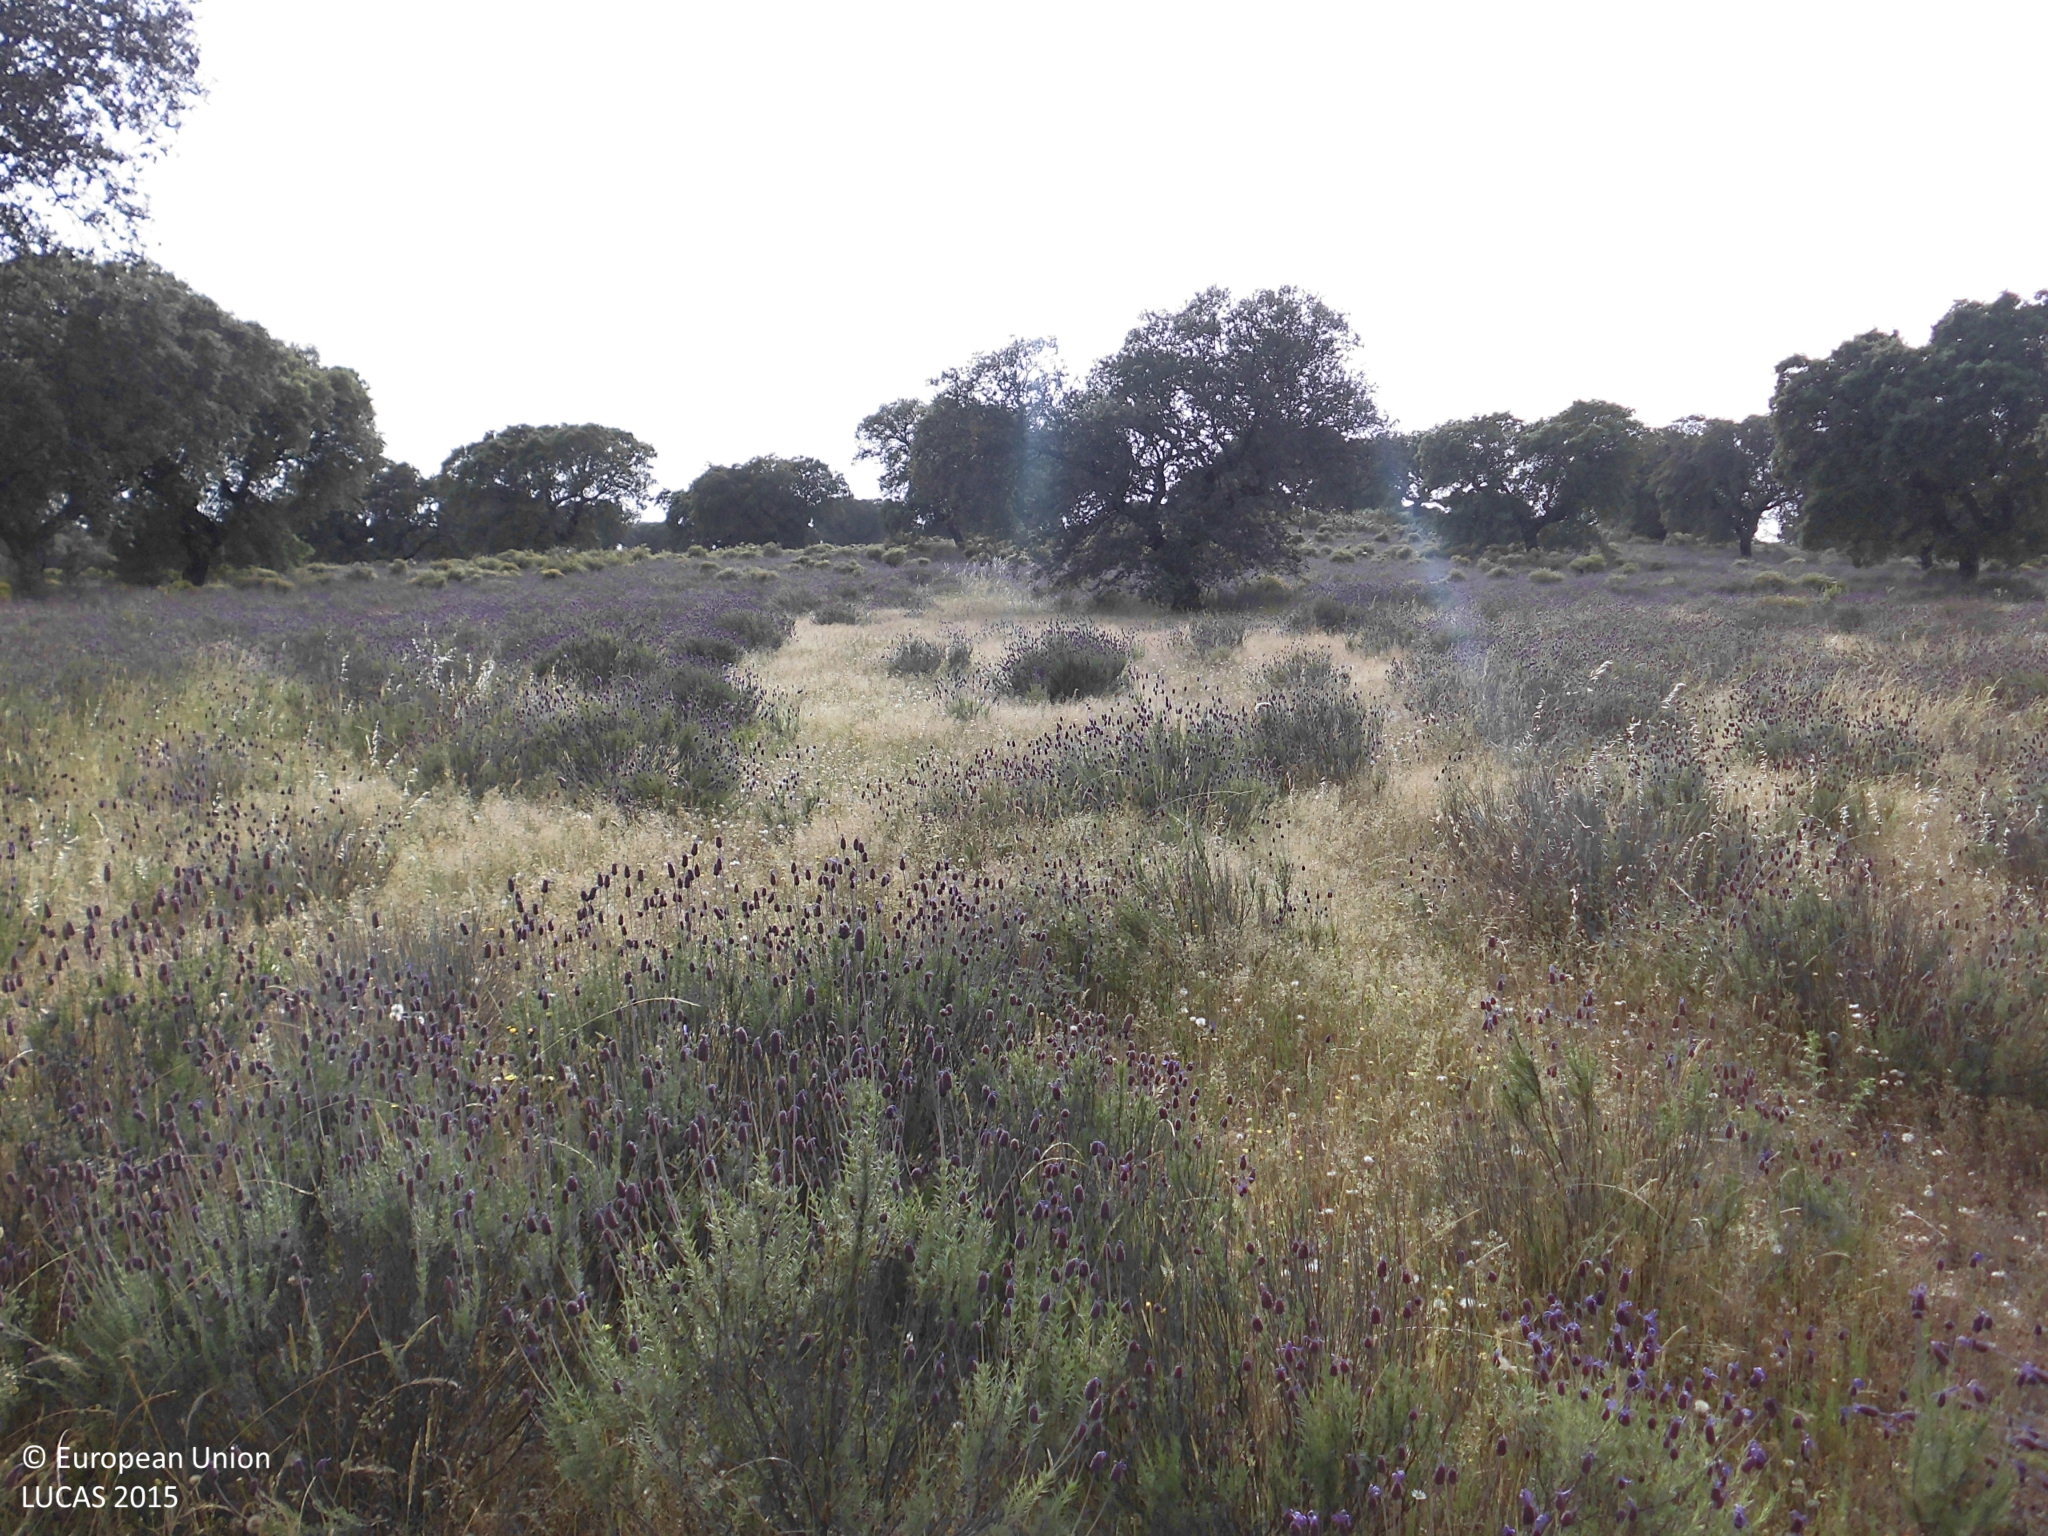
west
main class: Woodland
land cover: Broadleaved woodland
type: broadleaved evergreen forest
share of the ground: 25 - 50 %
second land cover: Grassland without tree/shrub cover
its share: > 75 %
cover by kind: herbaceous plants 55 %, broadleaved forest trees 30 %, shrubs 15 %
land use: Forestry
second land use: Agriculture (excluding fallow land and kitchen gardens)
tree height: > 5 m
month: May
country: ES
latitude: 39.6575
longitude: -6.1390
